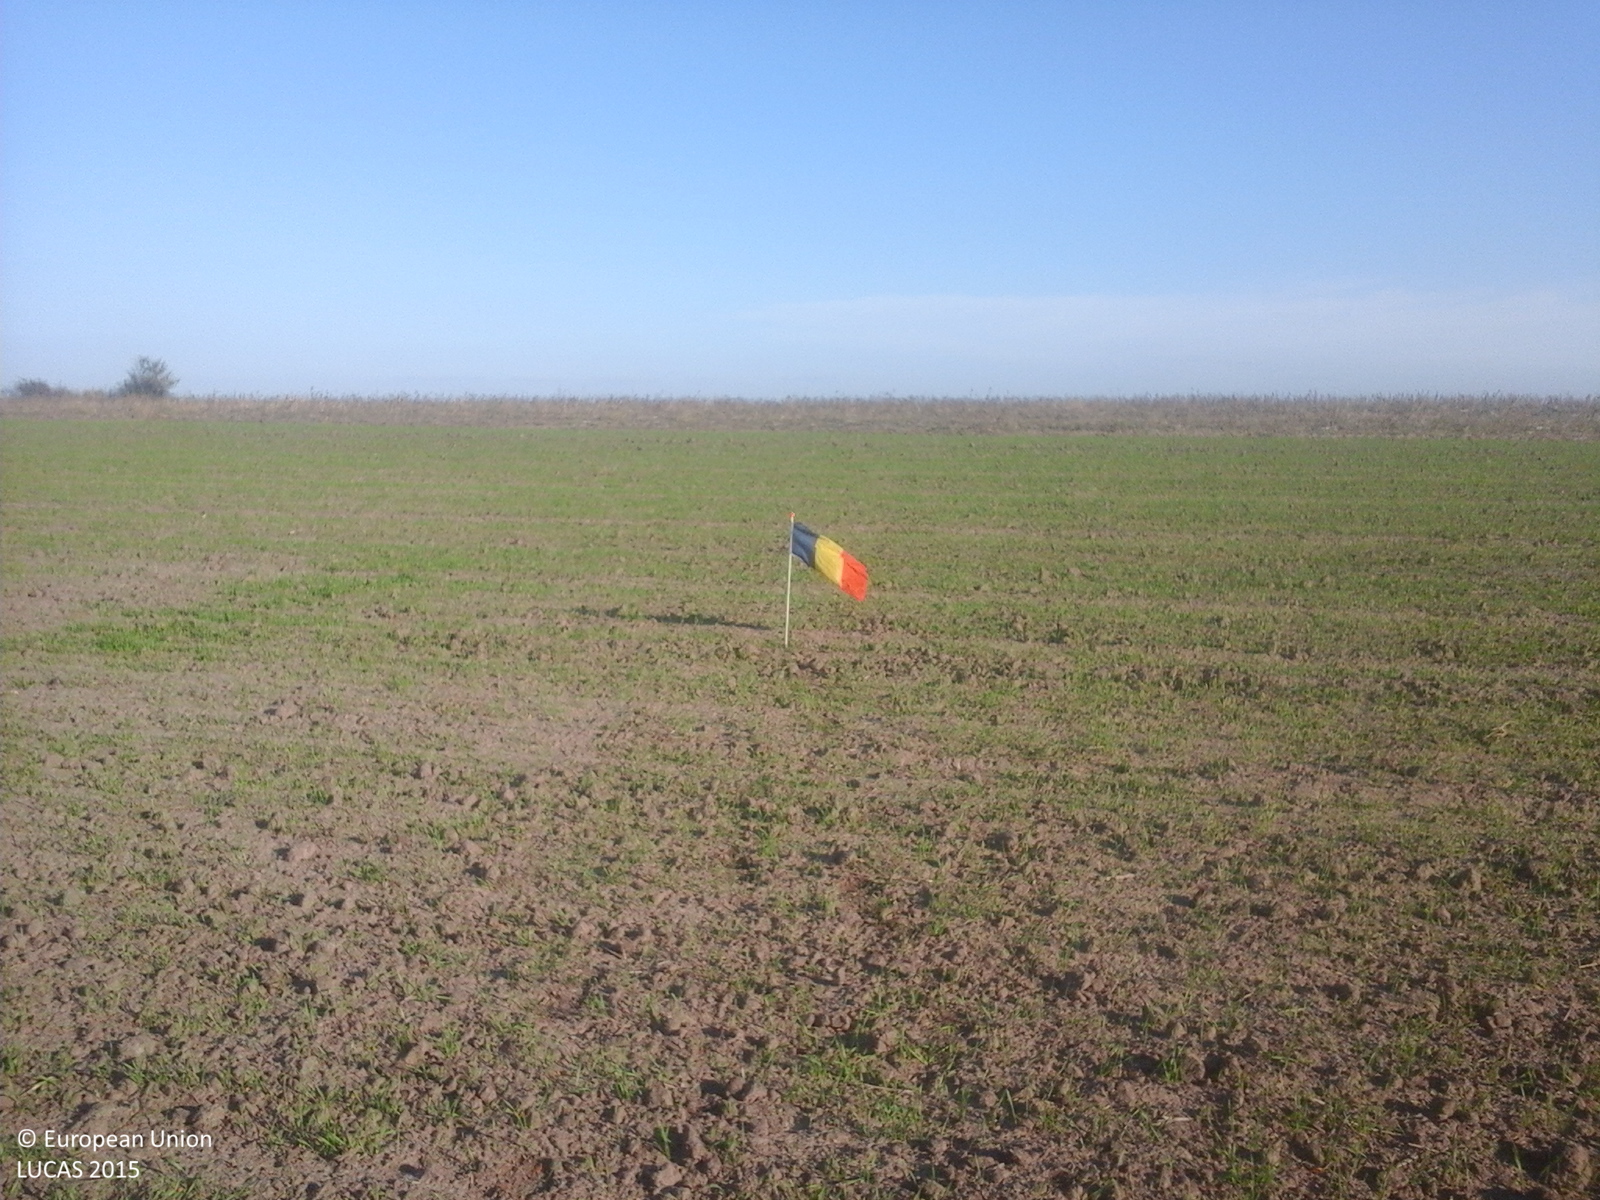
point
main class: Cropland
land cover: Common wheat
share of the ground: 10 - 25 %
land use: Agriculture (excluding fallow land and kitchen gardens)
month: October
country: RO
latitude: 45.2706
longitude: 27.3409
